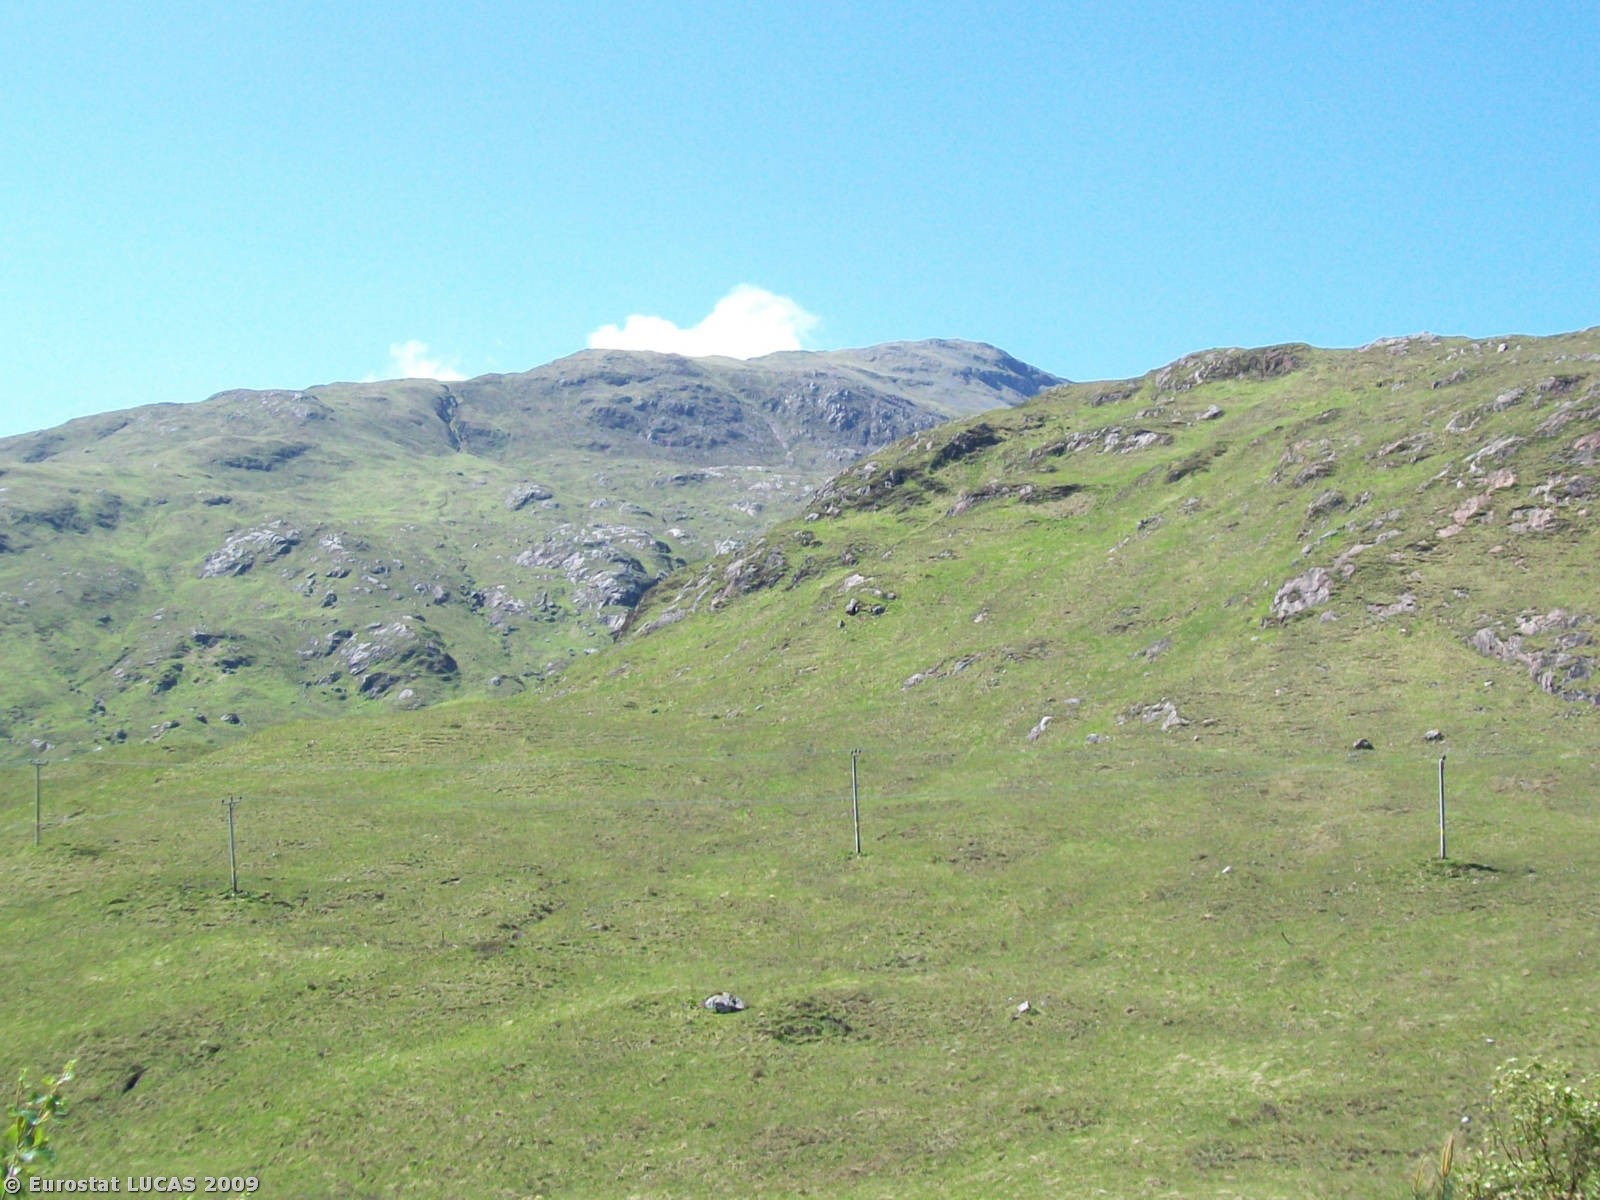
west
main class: Shrubland
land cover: Shrubland with sparse tree cover
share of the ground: > 75 %
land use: Forestry
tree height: > 5 m
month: May
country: GB
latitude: 56.6623
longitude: -5.4042
